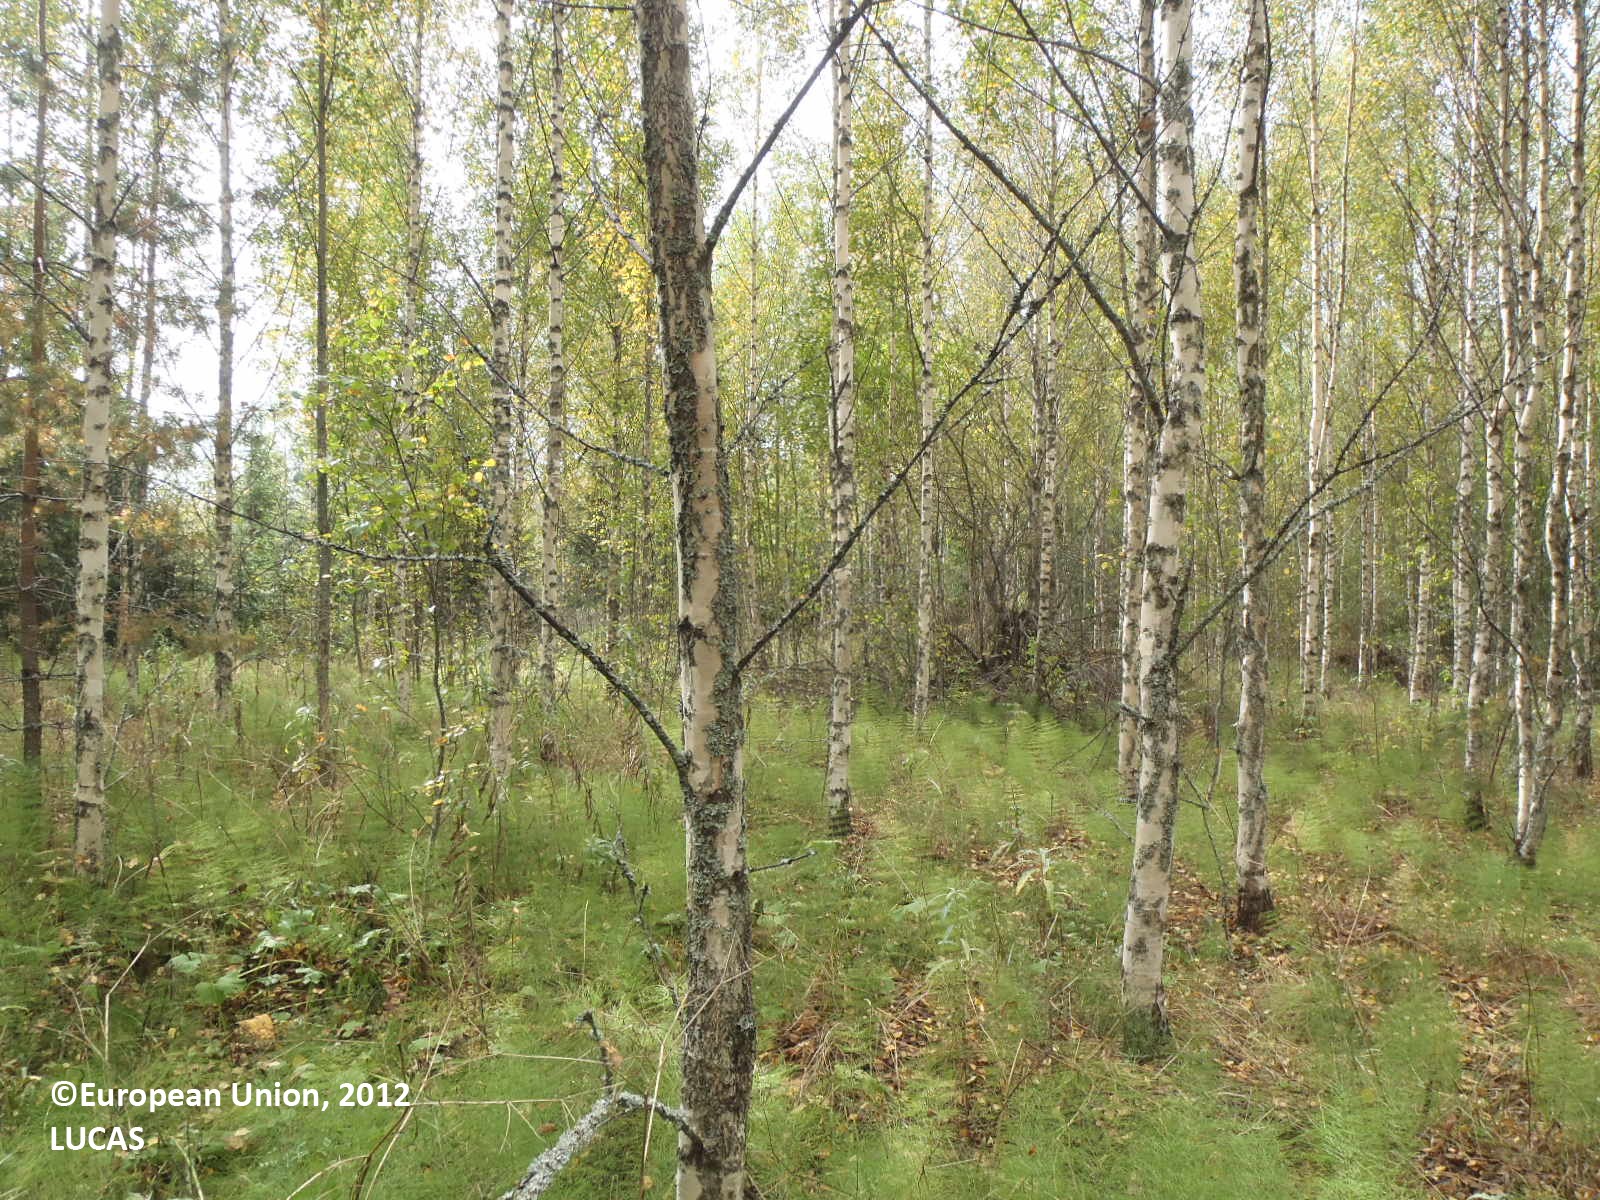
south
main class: Woodland
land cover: Broadleaved woodland
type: boreal forest
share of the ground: > 75 %
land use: Forestry
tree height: > 5 m
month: September
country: FI
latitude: 61.3206
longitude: 22.7138
